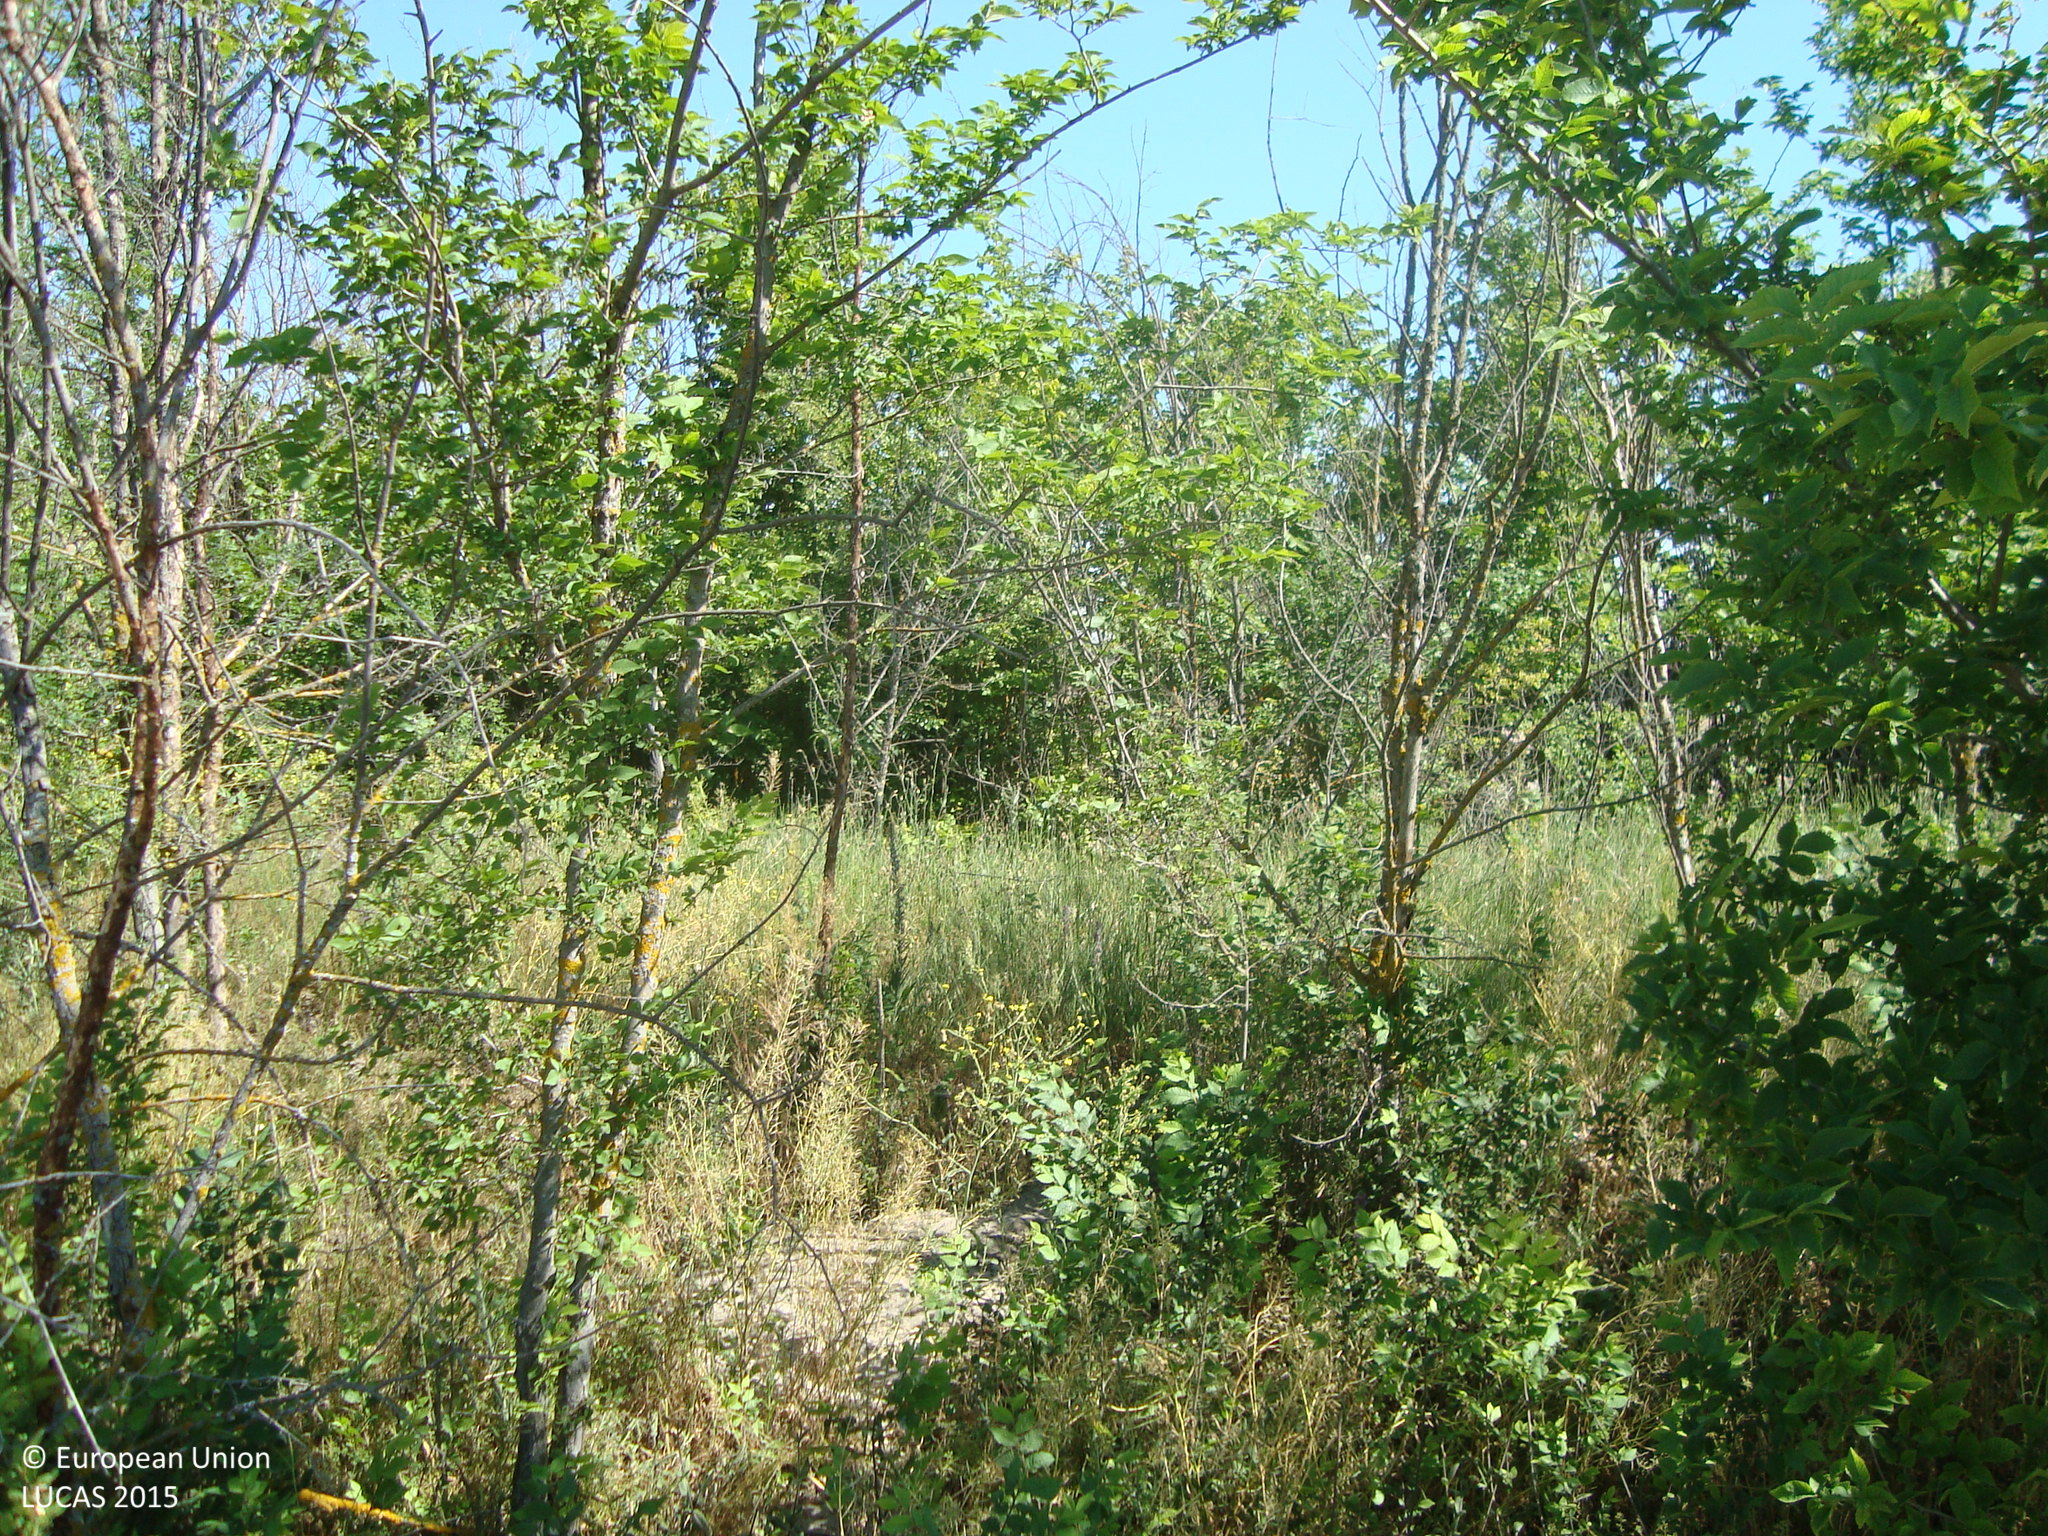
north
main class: Woodland
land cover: Broadleaved woodland
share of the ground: 10 - 25 %
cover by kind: herbaceous plants 75 %, broadleaved forest trees 20 %, shrubs 5 %
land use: Semi-natural and natural areas not in use
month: June
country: ES
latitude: 41.5447
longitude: -4.6556
